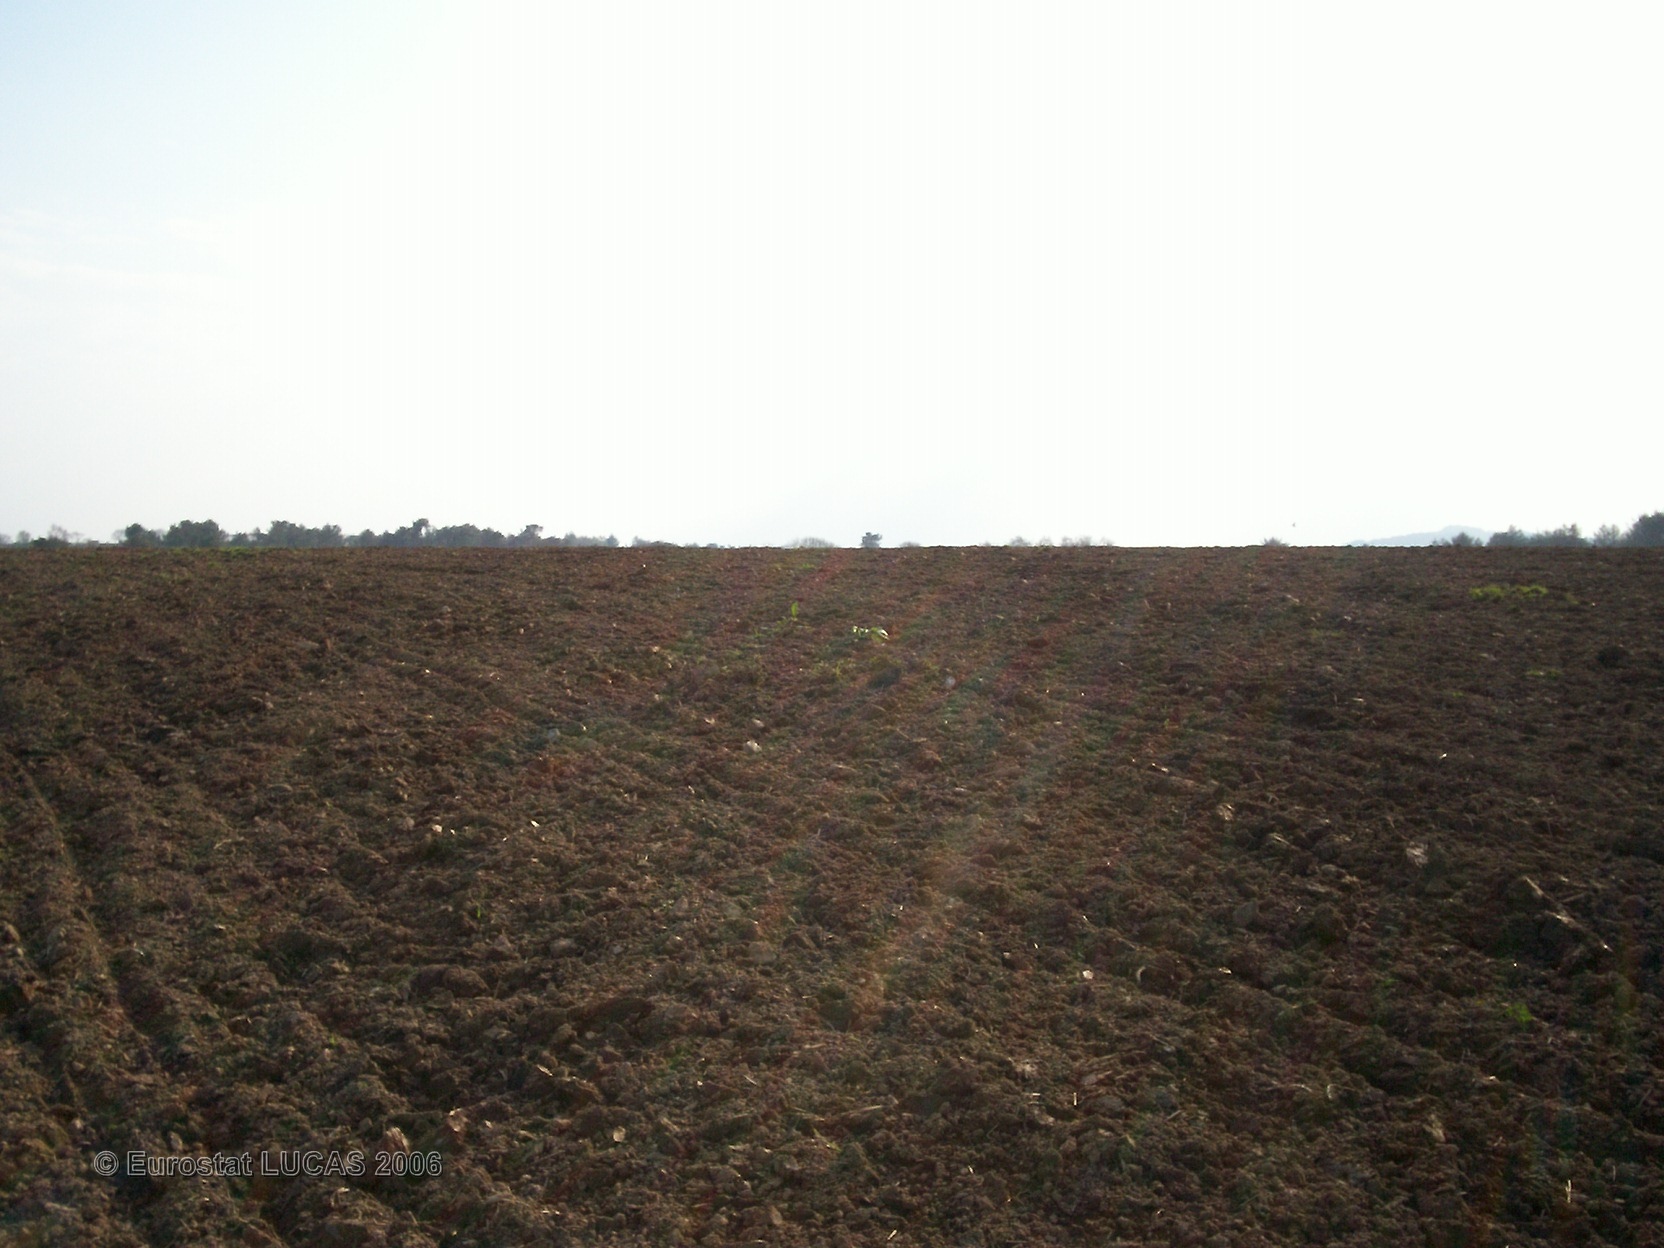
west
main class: Cropland
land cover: Maize
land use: Agriculture (excluding fallow land and kitchen gardens)
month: June
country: FR
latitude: 48.4581
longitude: -3.6998
